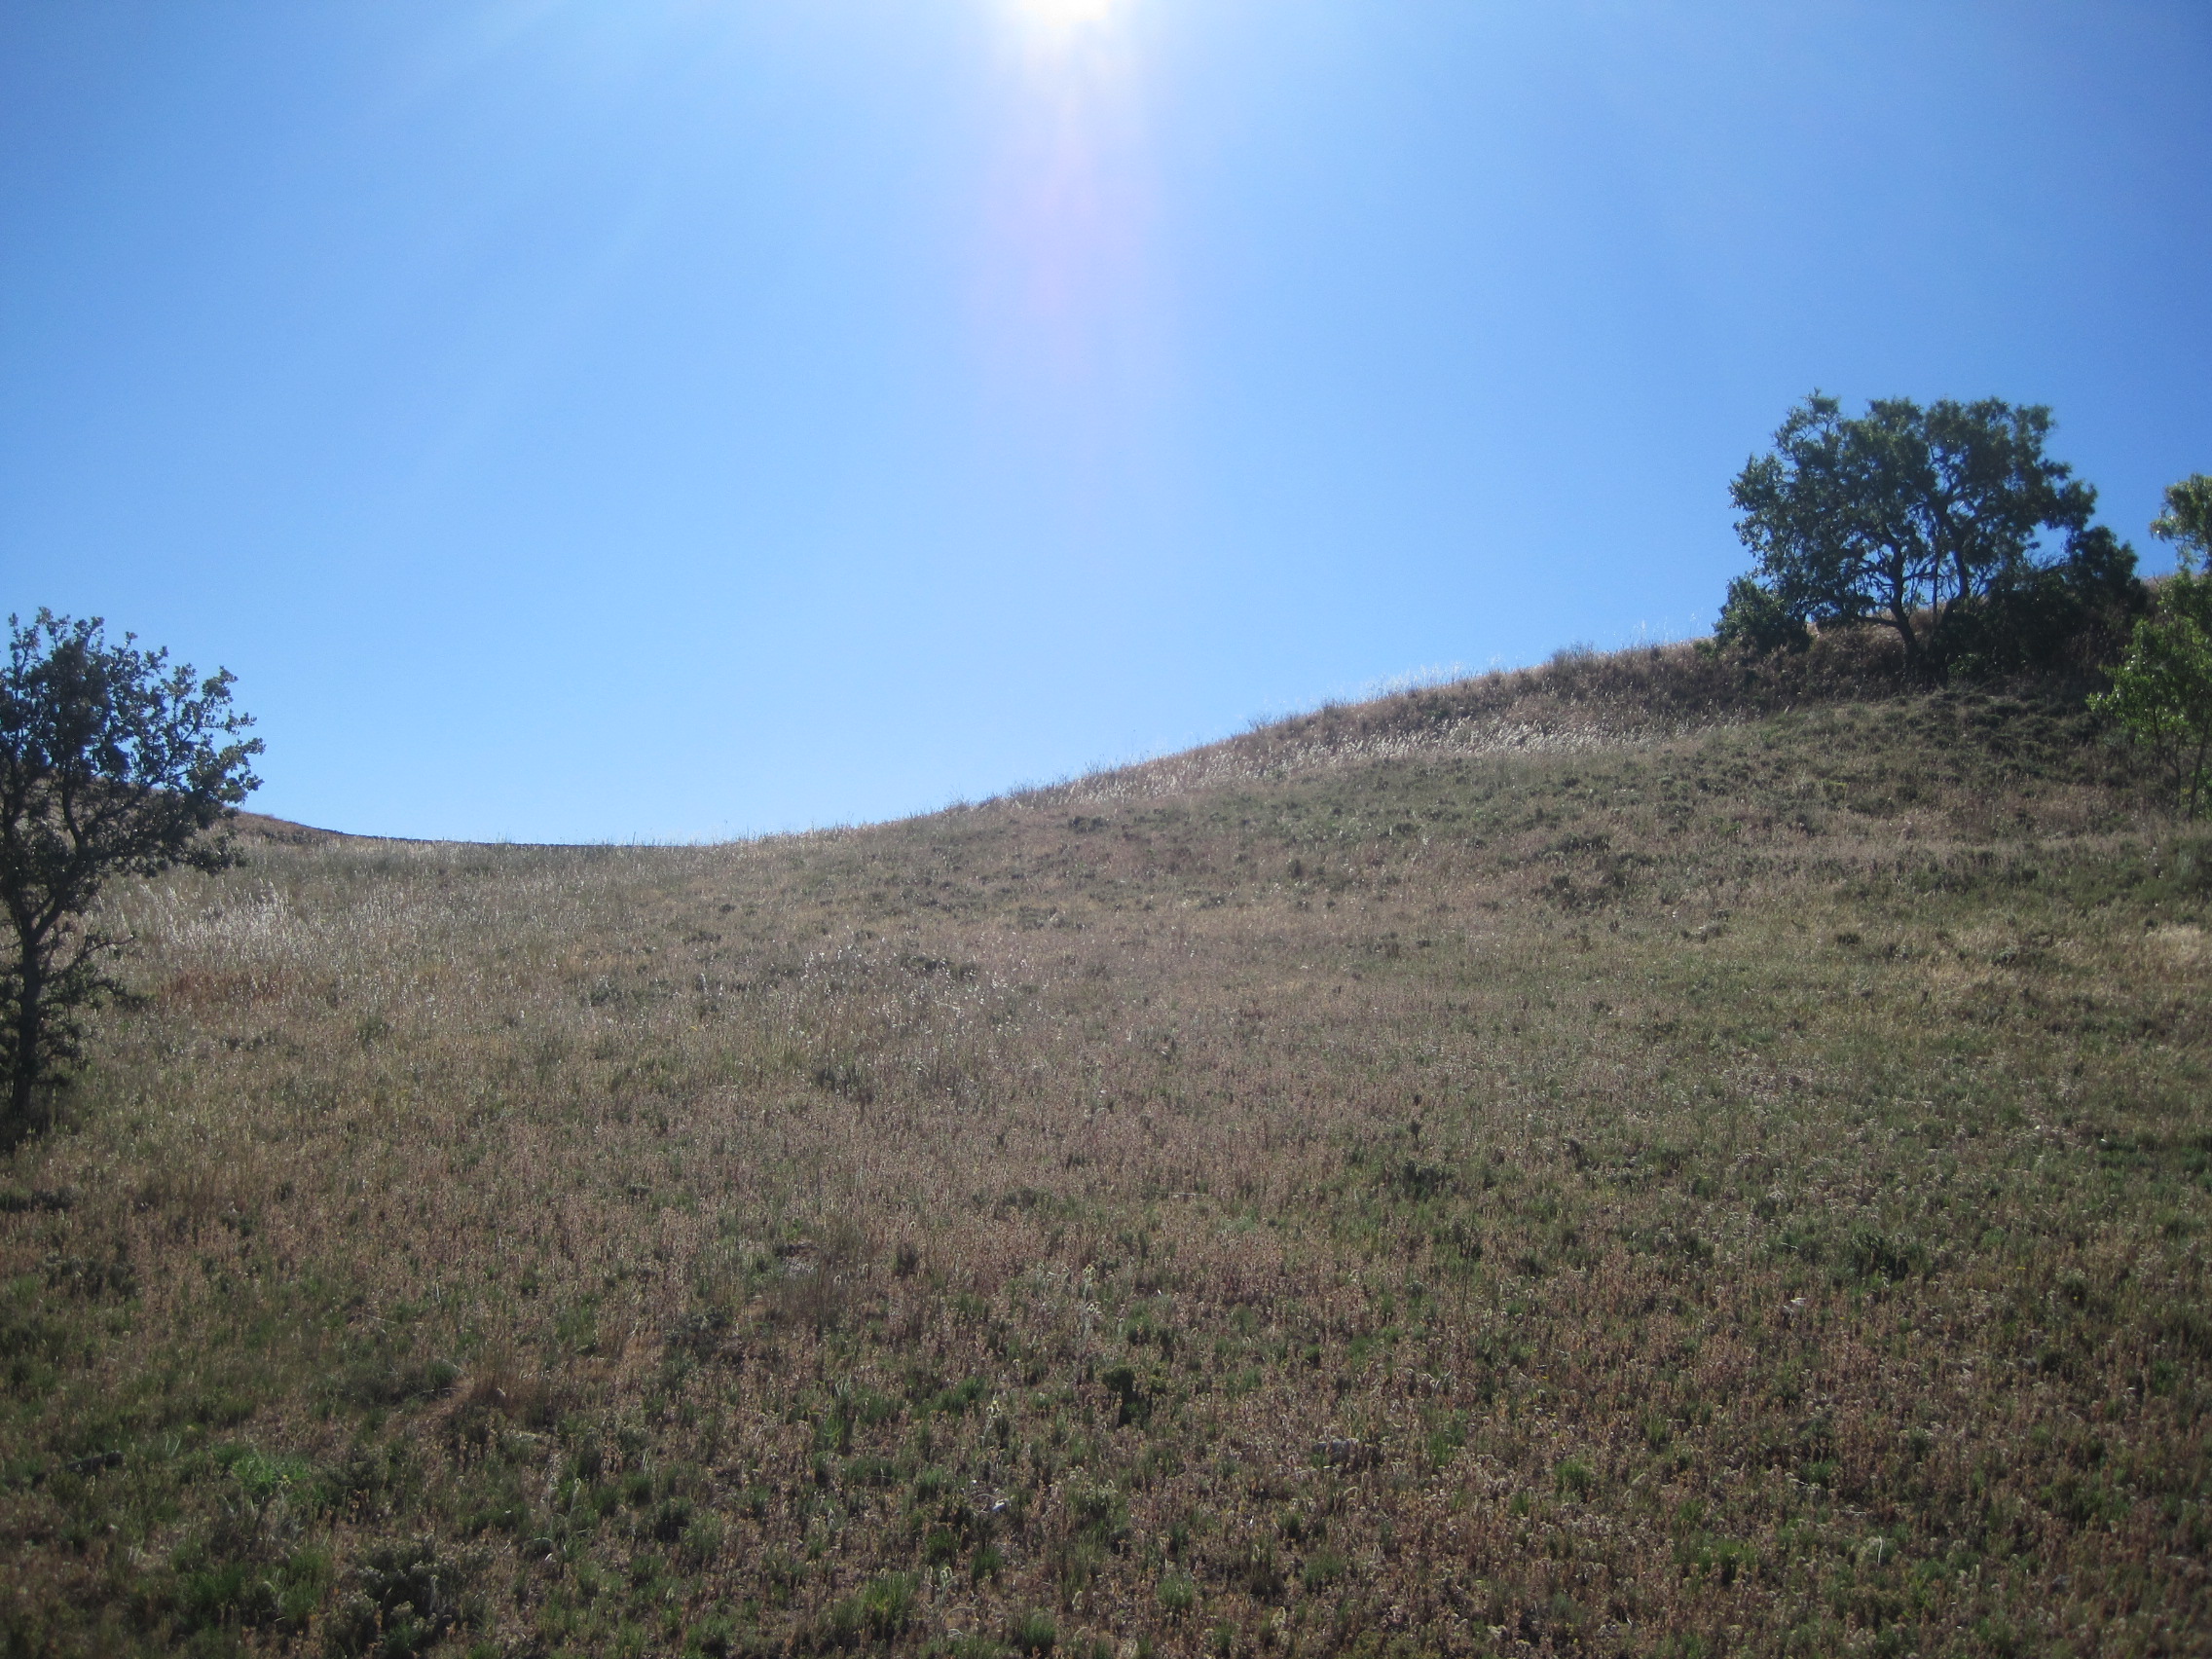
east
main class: Grassland
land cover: Grassland with sparse tree/shrub cover
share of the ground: > 75 %
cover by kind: herbaceous plants 95 %, broadleaved forest trees 5 %
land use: Semi-natural and natural areas not in use
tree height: < 5 m
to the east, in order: Grassland with sparse tree/shrub cover; Other bare soil; Grass margins; Common wheat
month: May
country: ES
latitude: 41.1829
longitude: -5.3456
